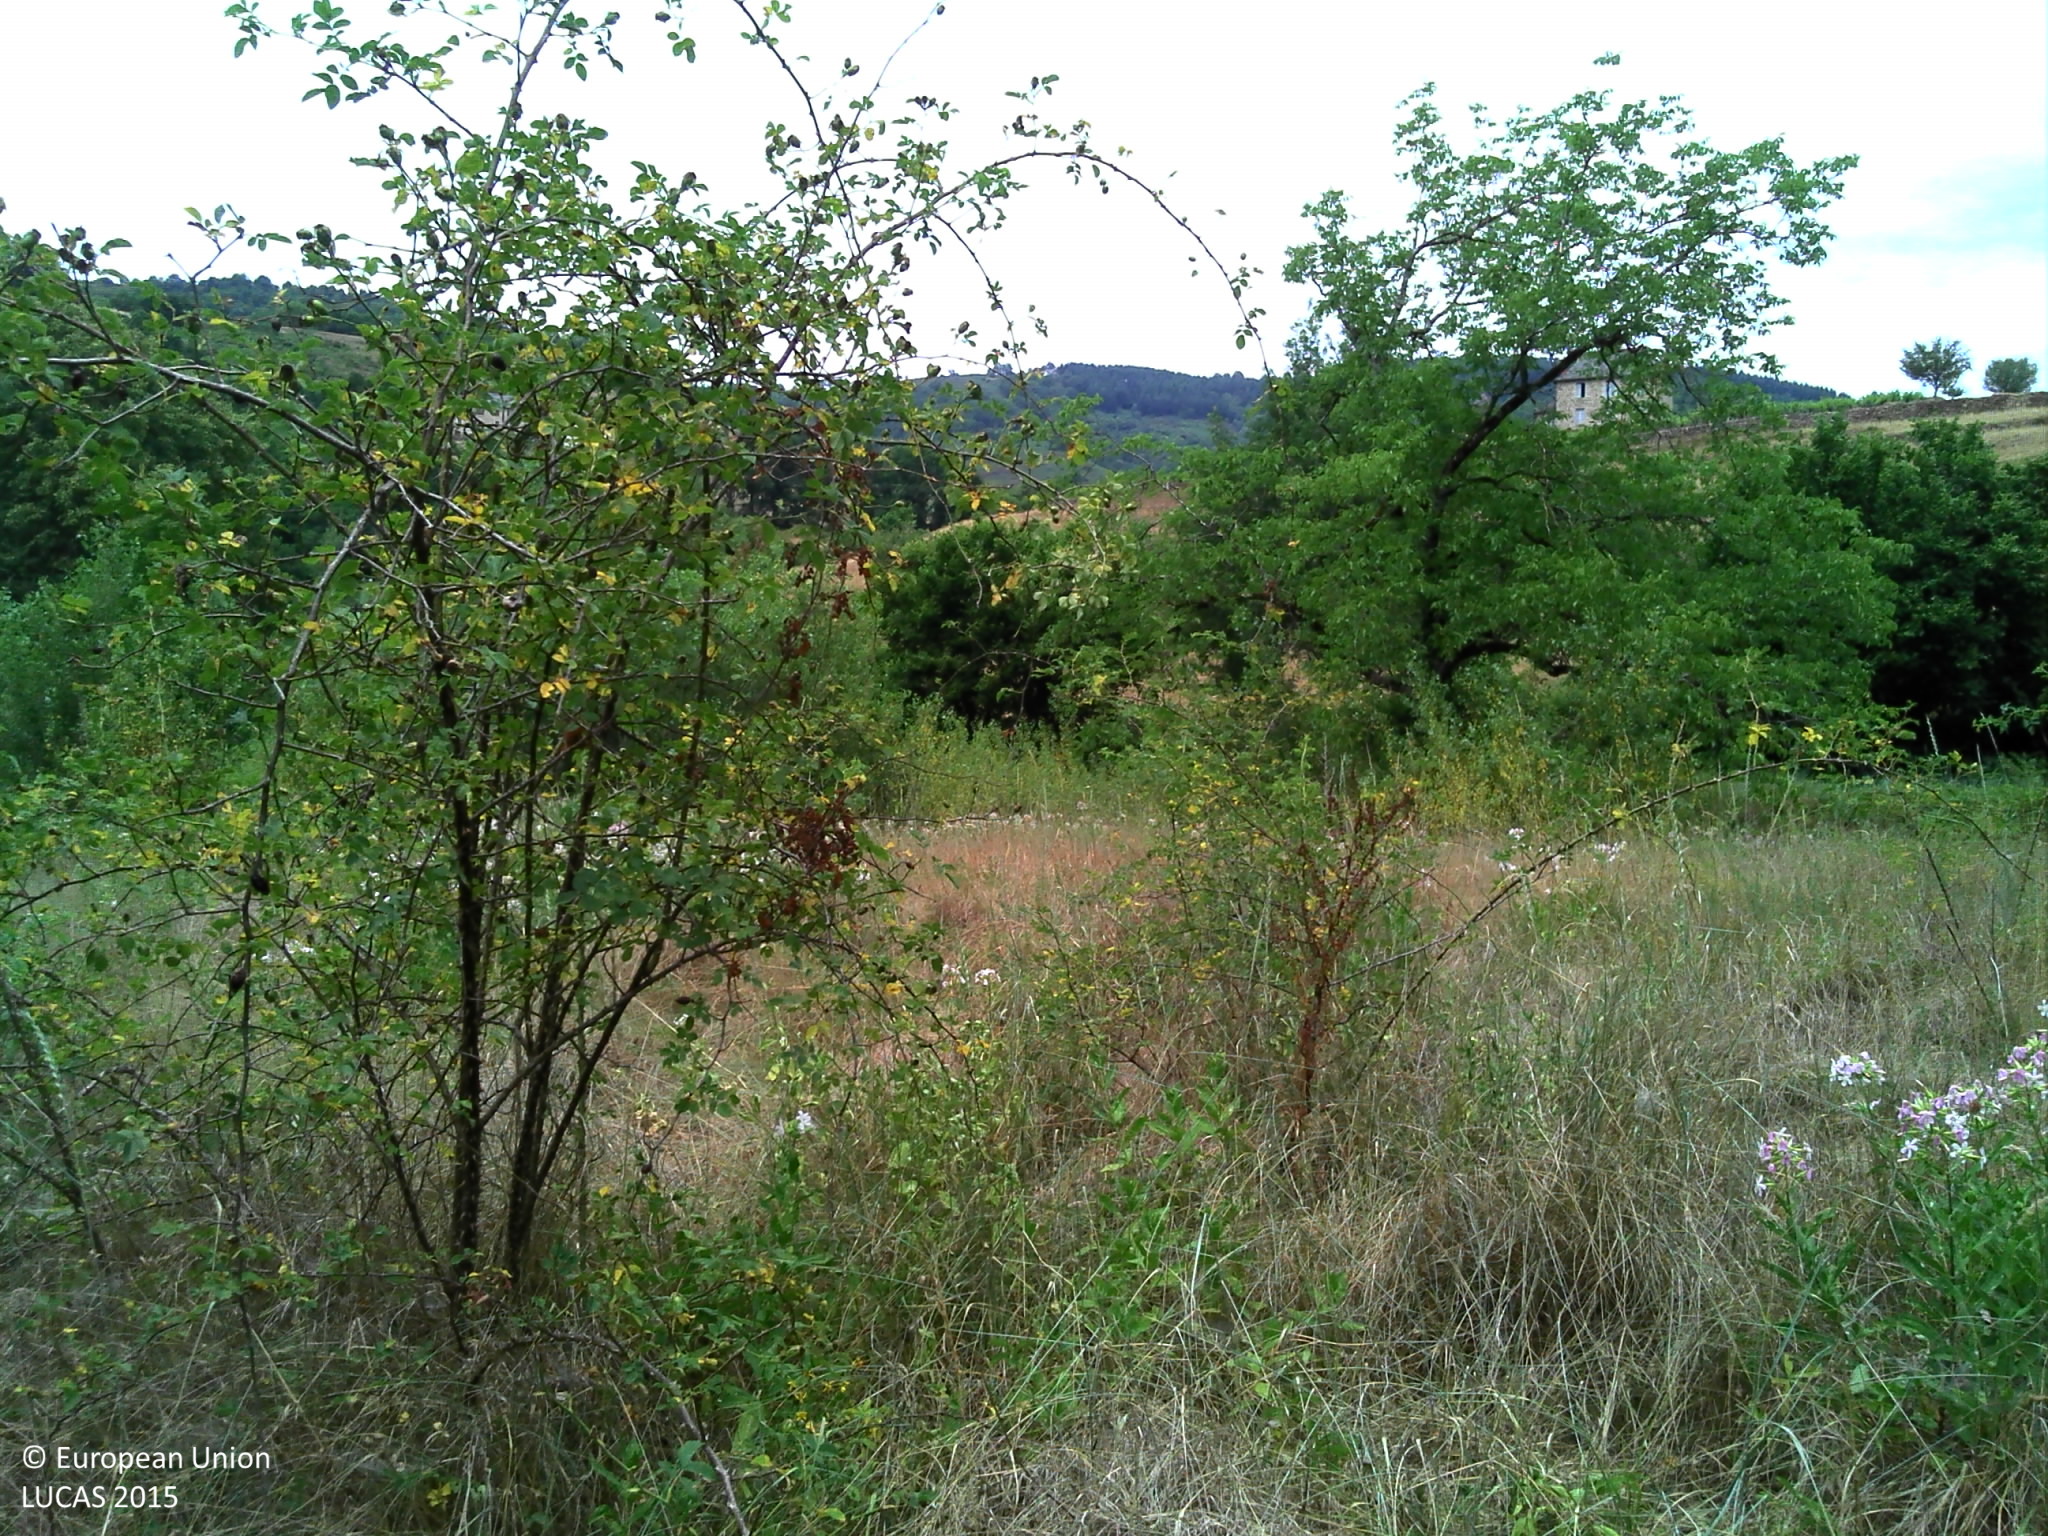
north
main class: Shrubland
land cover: Shrubland with sparse tree cover
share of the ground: > 75 %
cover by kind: shrubs 60 %, herbaceous plants 35 %, broadleaved forest trees 5 %
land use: Agriculture (excluding fallow land and kitchen gardens)
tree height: > 5 m
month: July
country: FR
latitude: 44.6438
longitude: 2.5507
